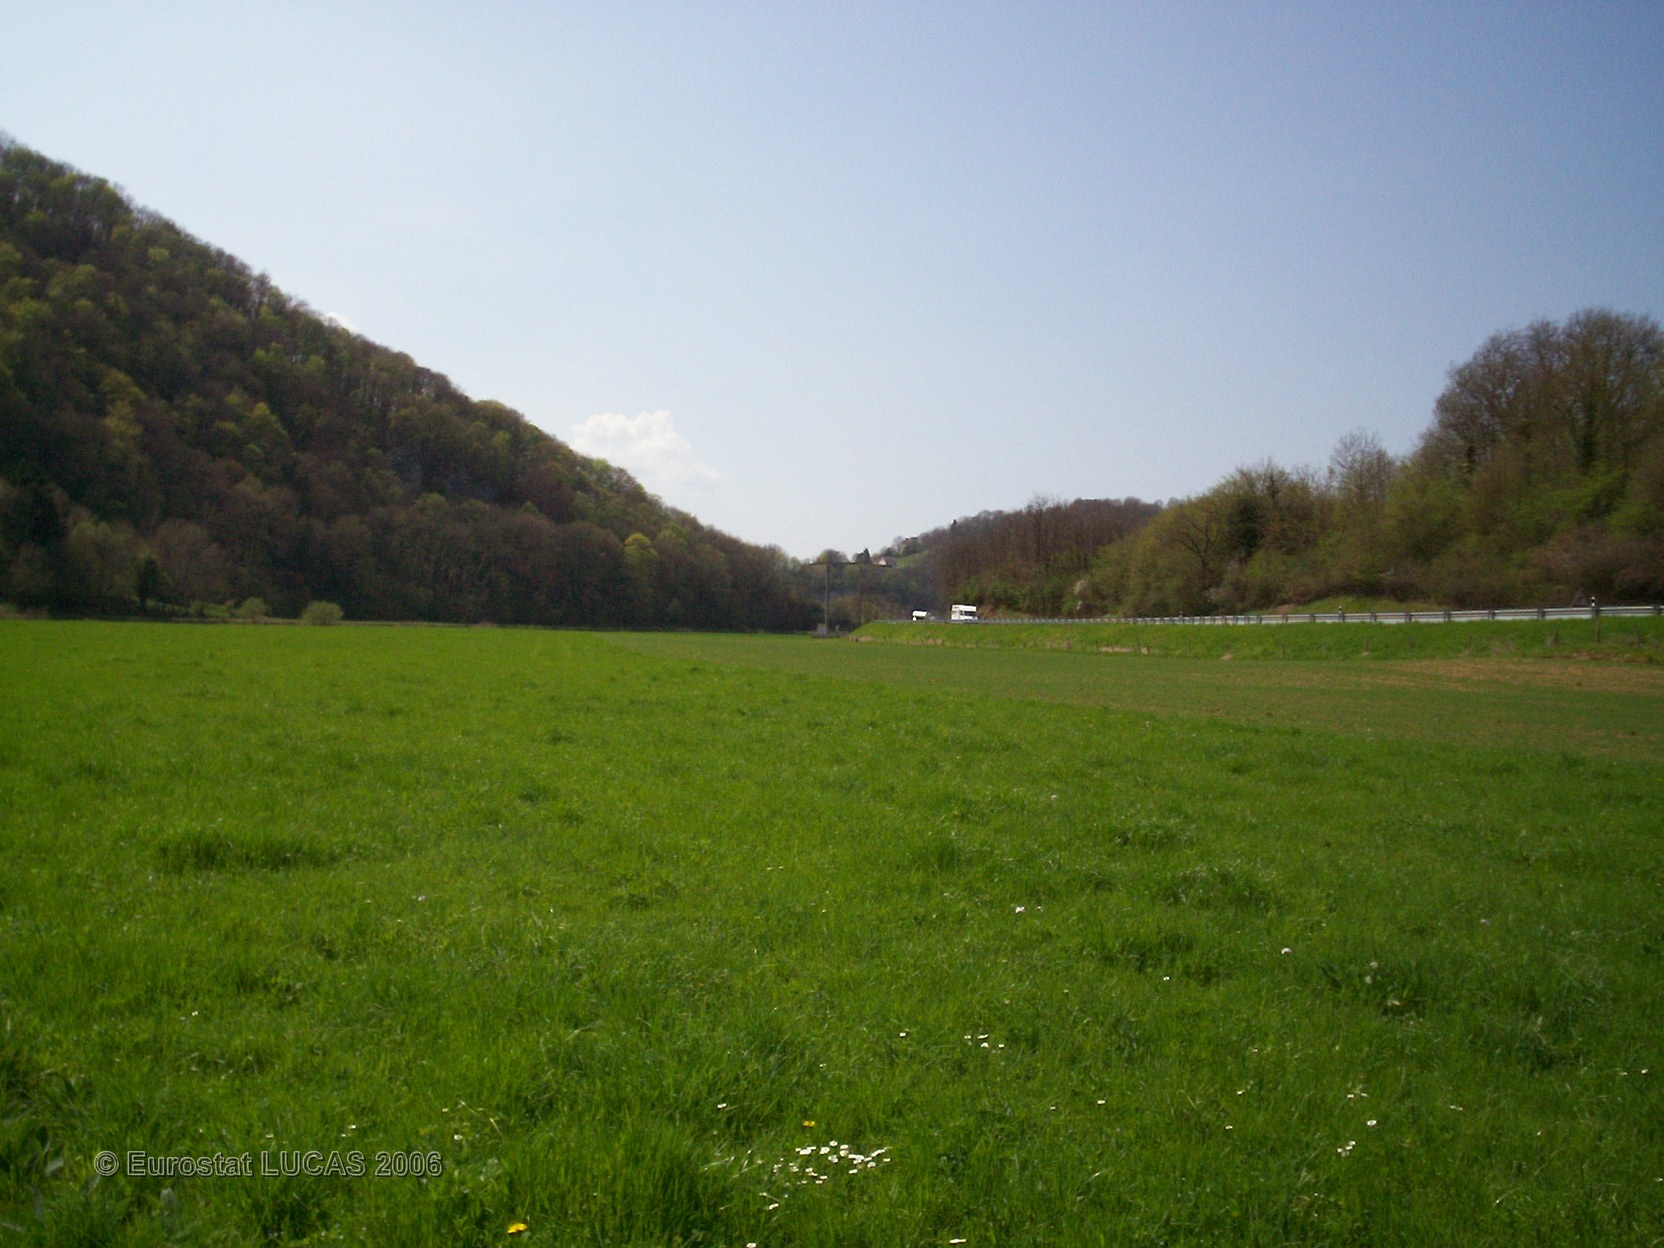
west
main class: Grassland
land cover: Grassland without tree/shrub cover
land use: Agriculture (excluding fallow land and kitchen gardens)
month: April
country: FR
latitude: 47.3537
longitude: 6.3876
